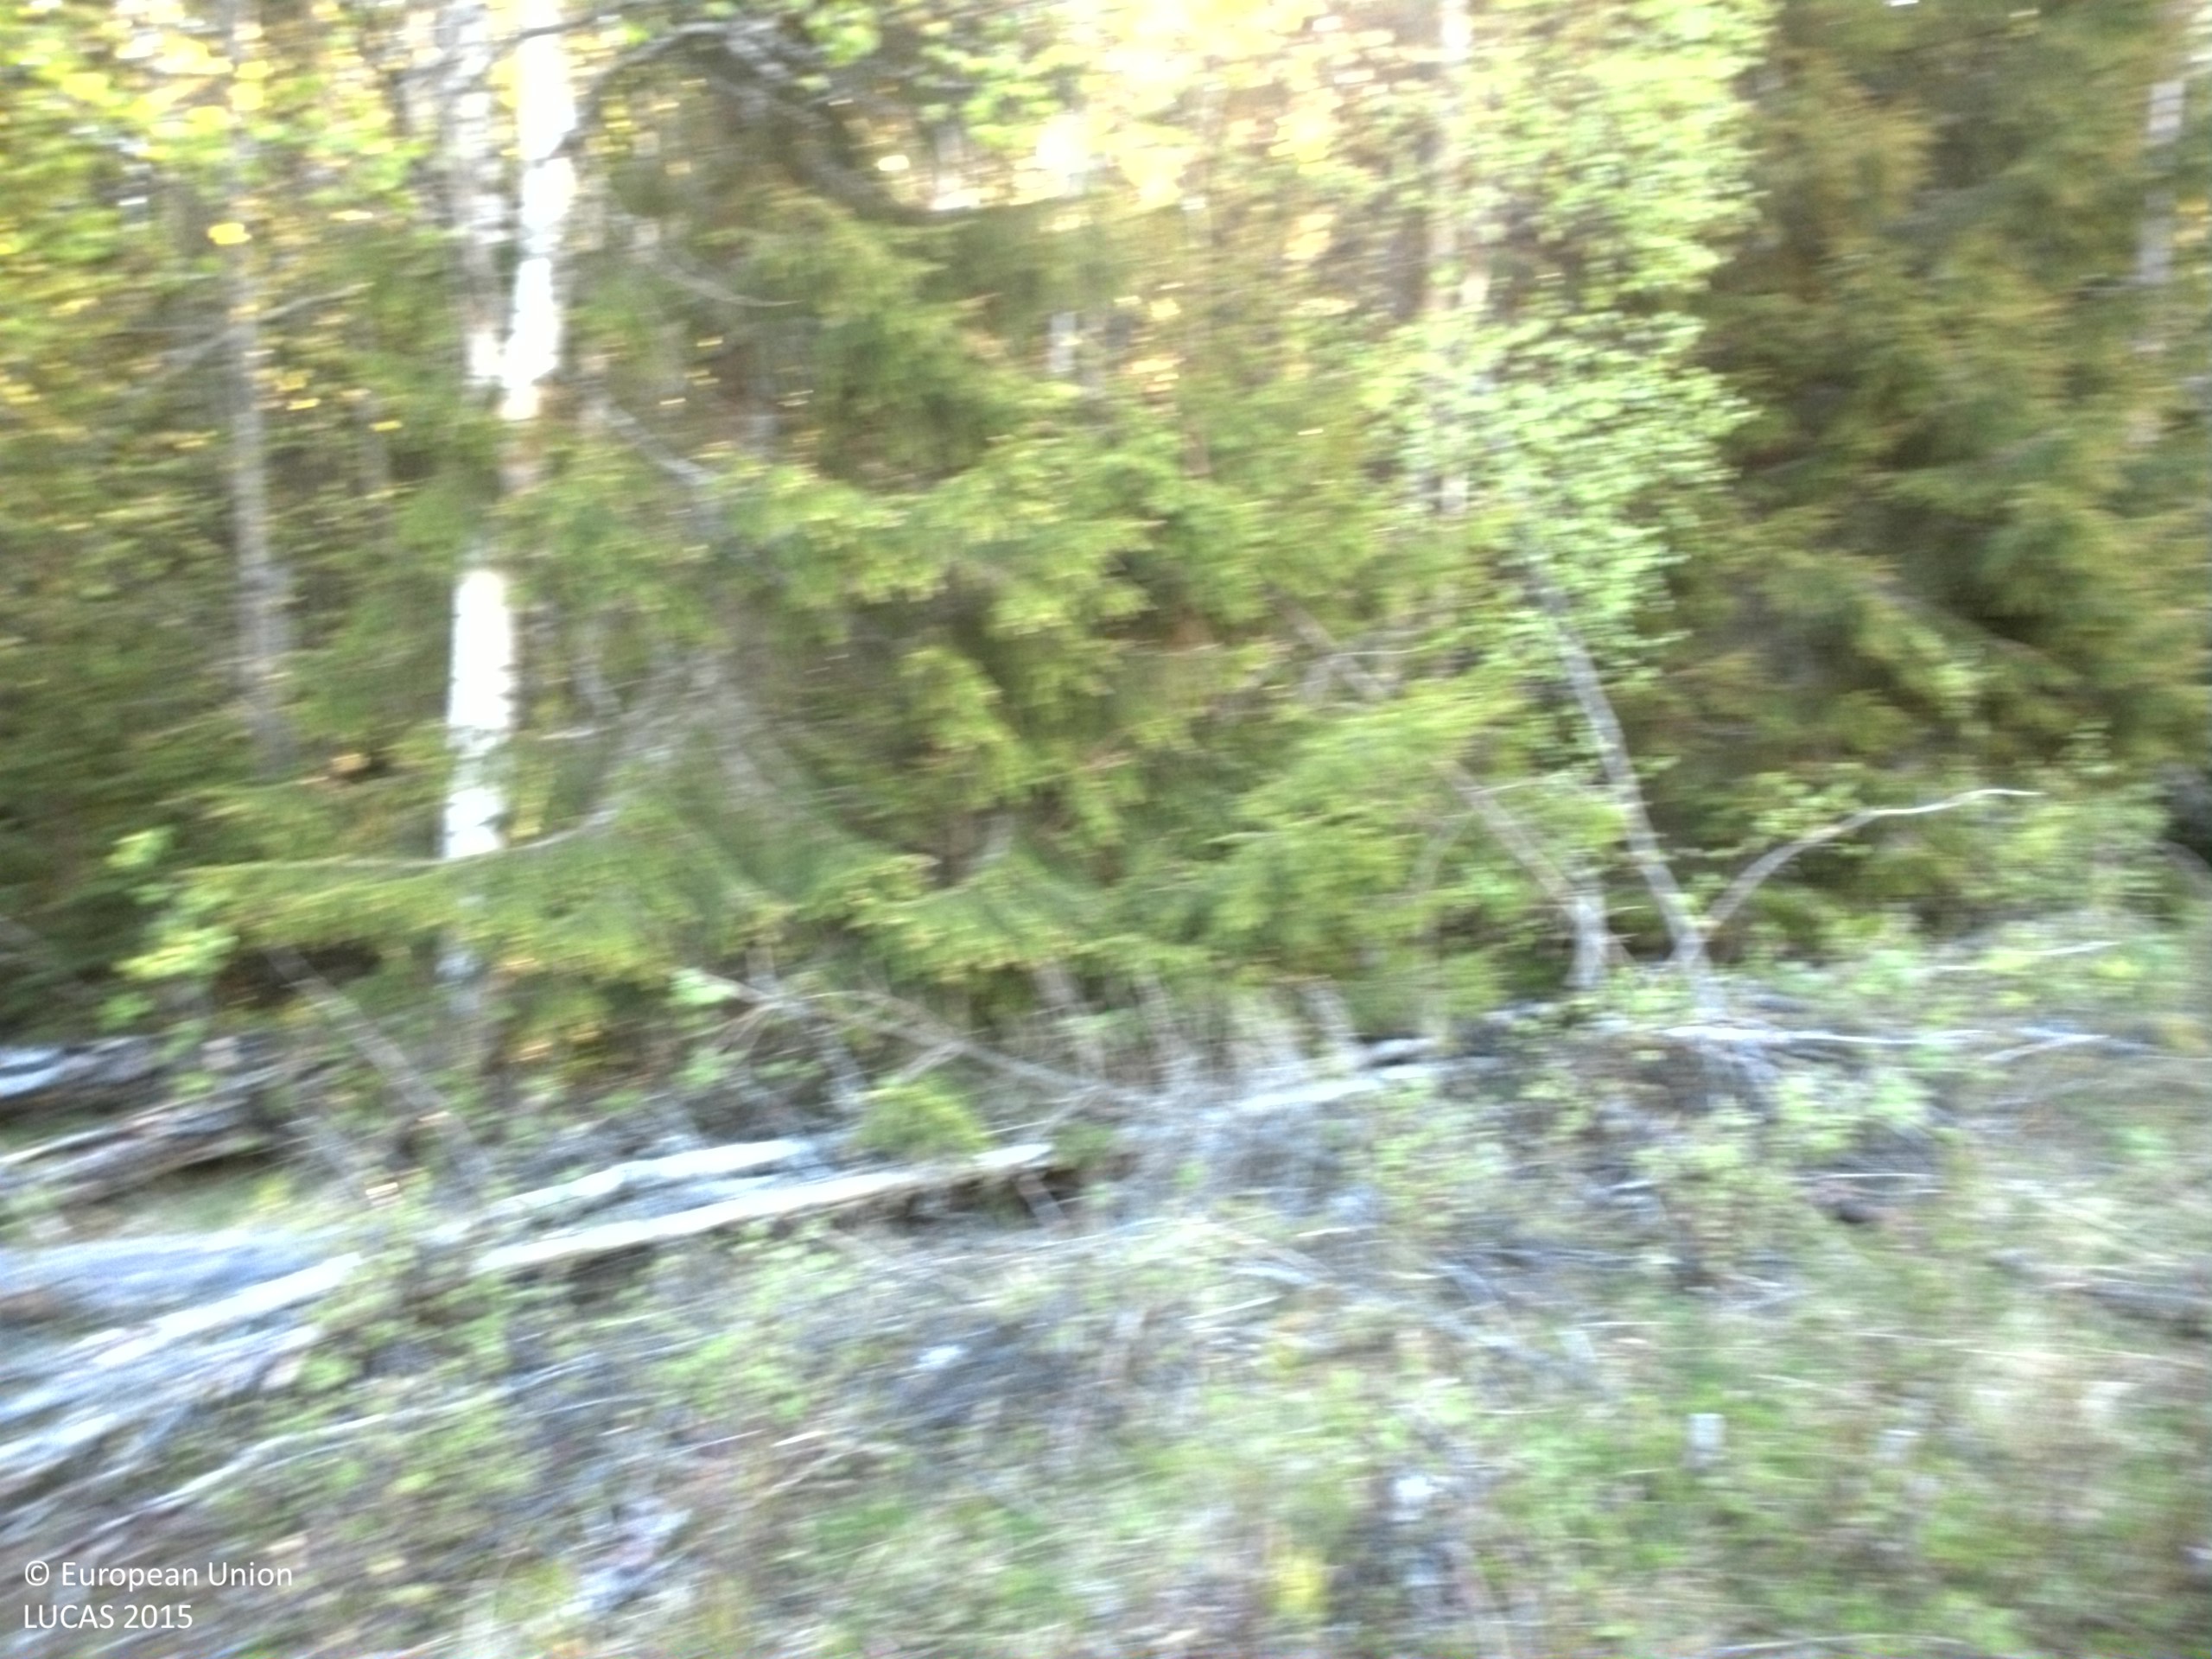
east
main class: Artificial land
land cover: Other artificial areas
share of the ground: > 75 %
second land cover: Broadleaved woodland
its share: 50 - 75 %
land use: Electricity, gas and thermal power distribution
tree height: < 5 m
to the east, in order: Artificial constructions in urban areas; Broadleaved woodland; Spruce dominated coniferous woodland; Pine dominated coniferous woodland; Spruce dominated mixed woodland
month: May
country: SE
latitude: 63.0055
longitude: 17.8570
